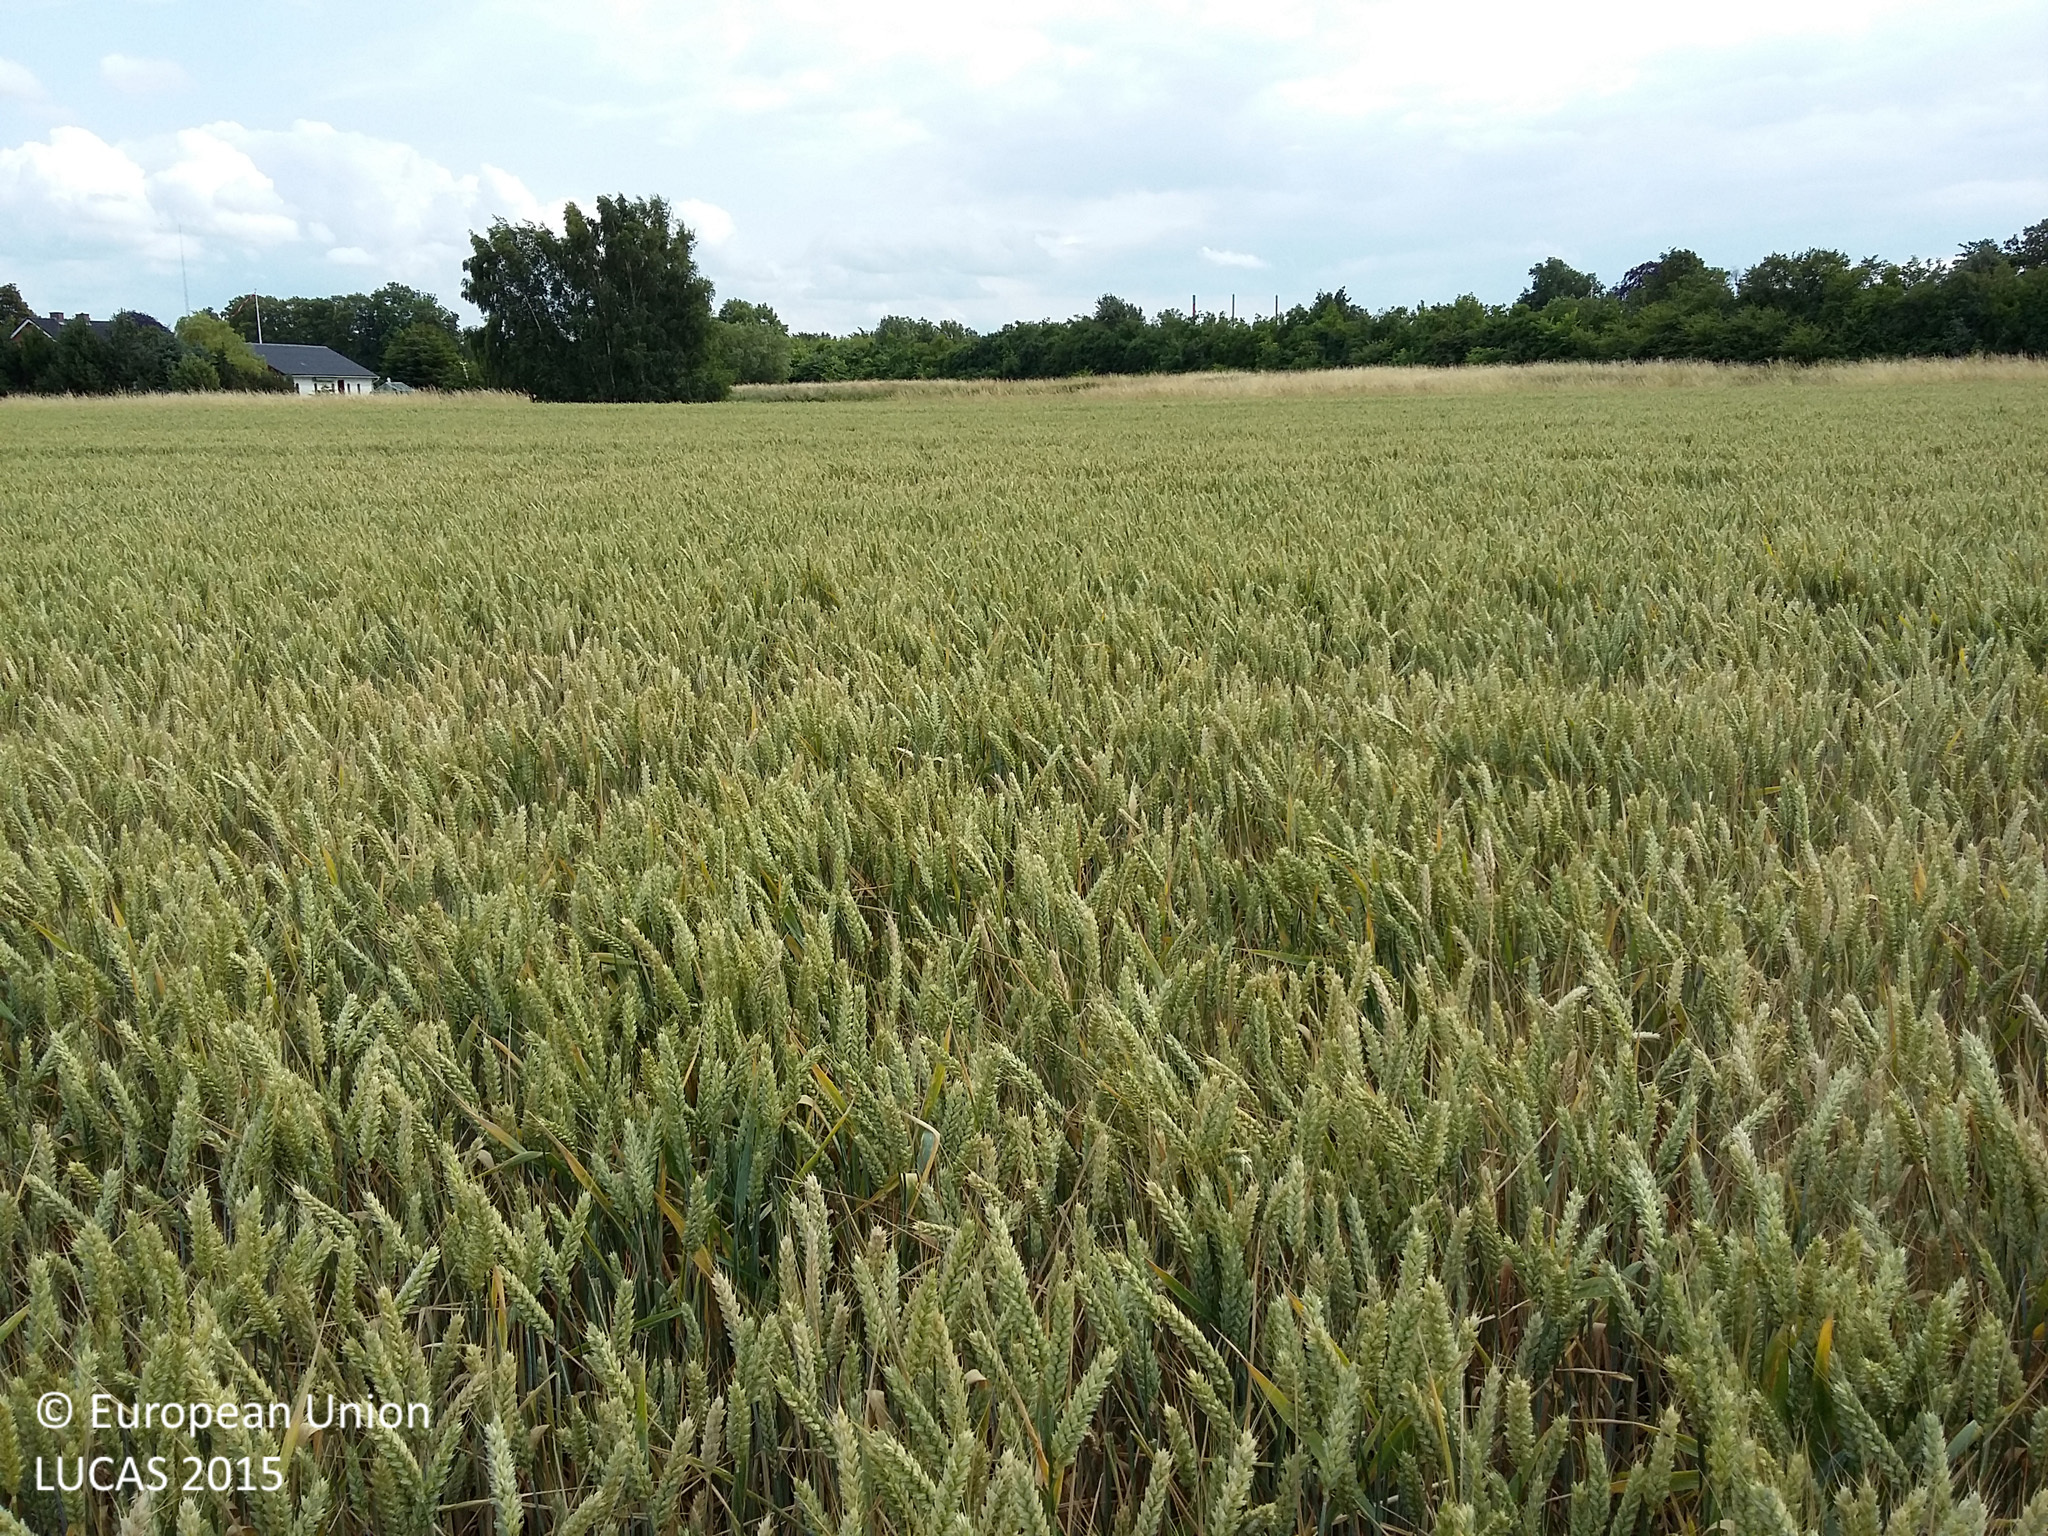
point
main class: Cropland
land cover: Common wheat
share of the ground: > 75 %
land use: Agriculture (excluding fallow land and kitchen gardens)
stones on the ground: < 10 %
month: July
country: DK
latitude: 55.5162
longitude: 11.2816
